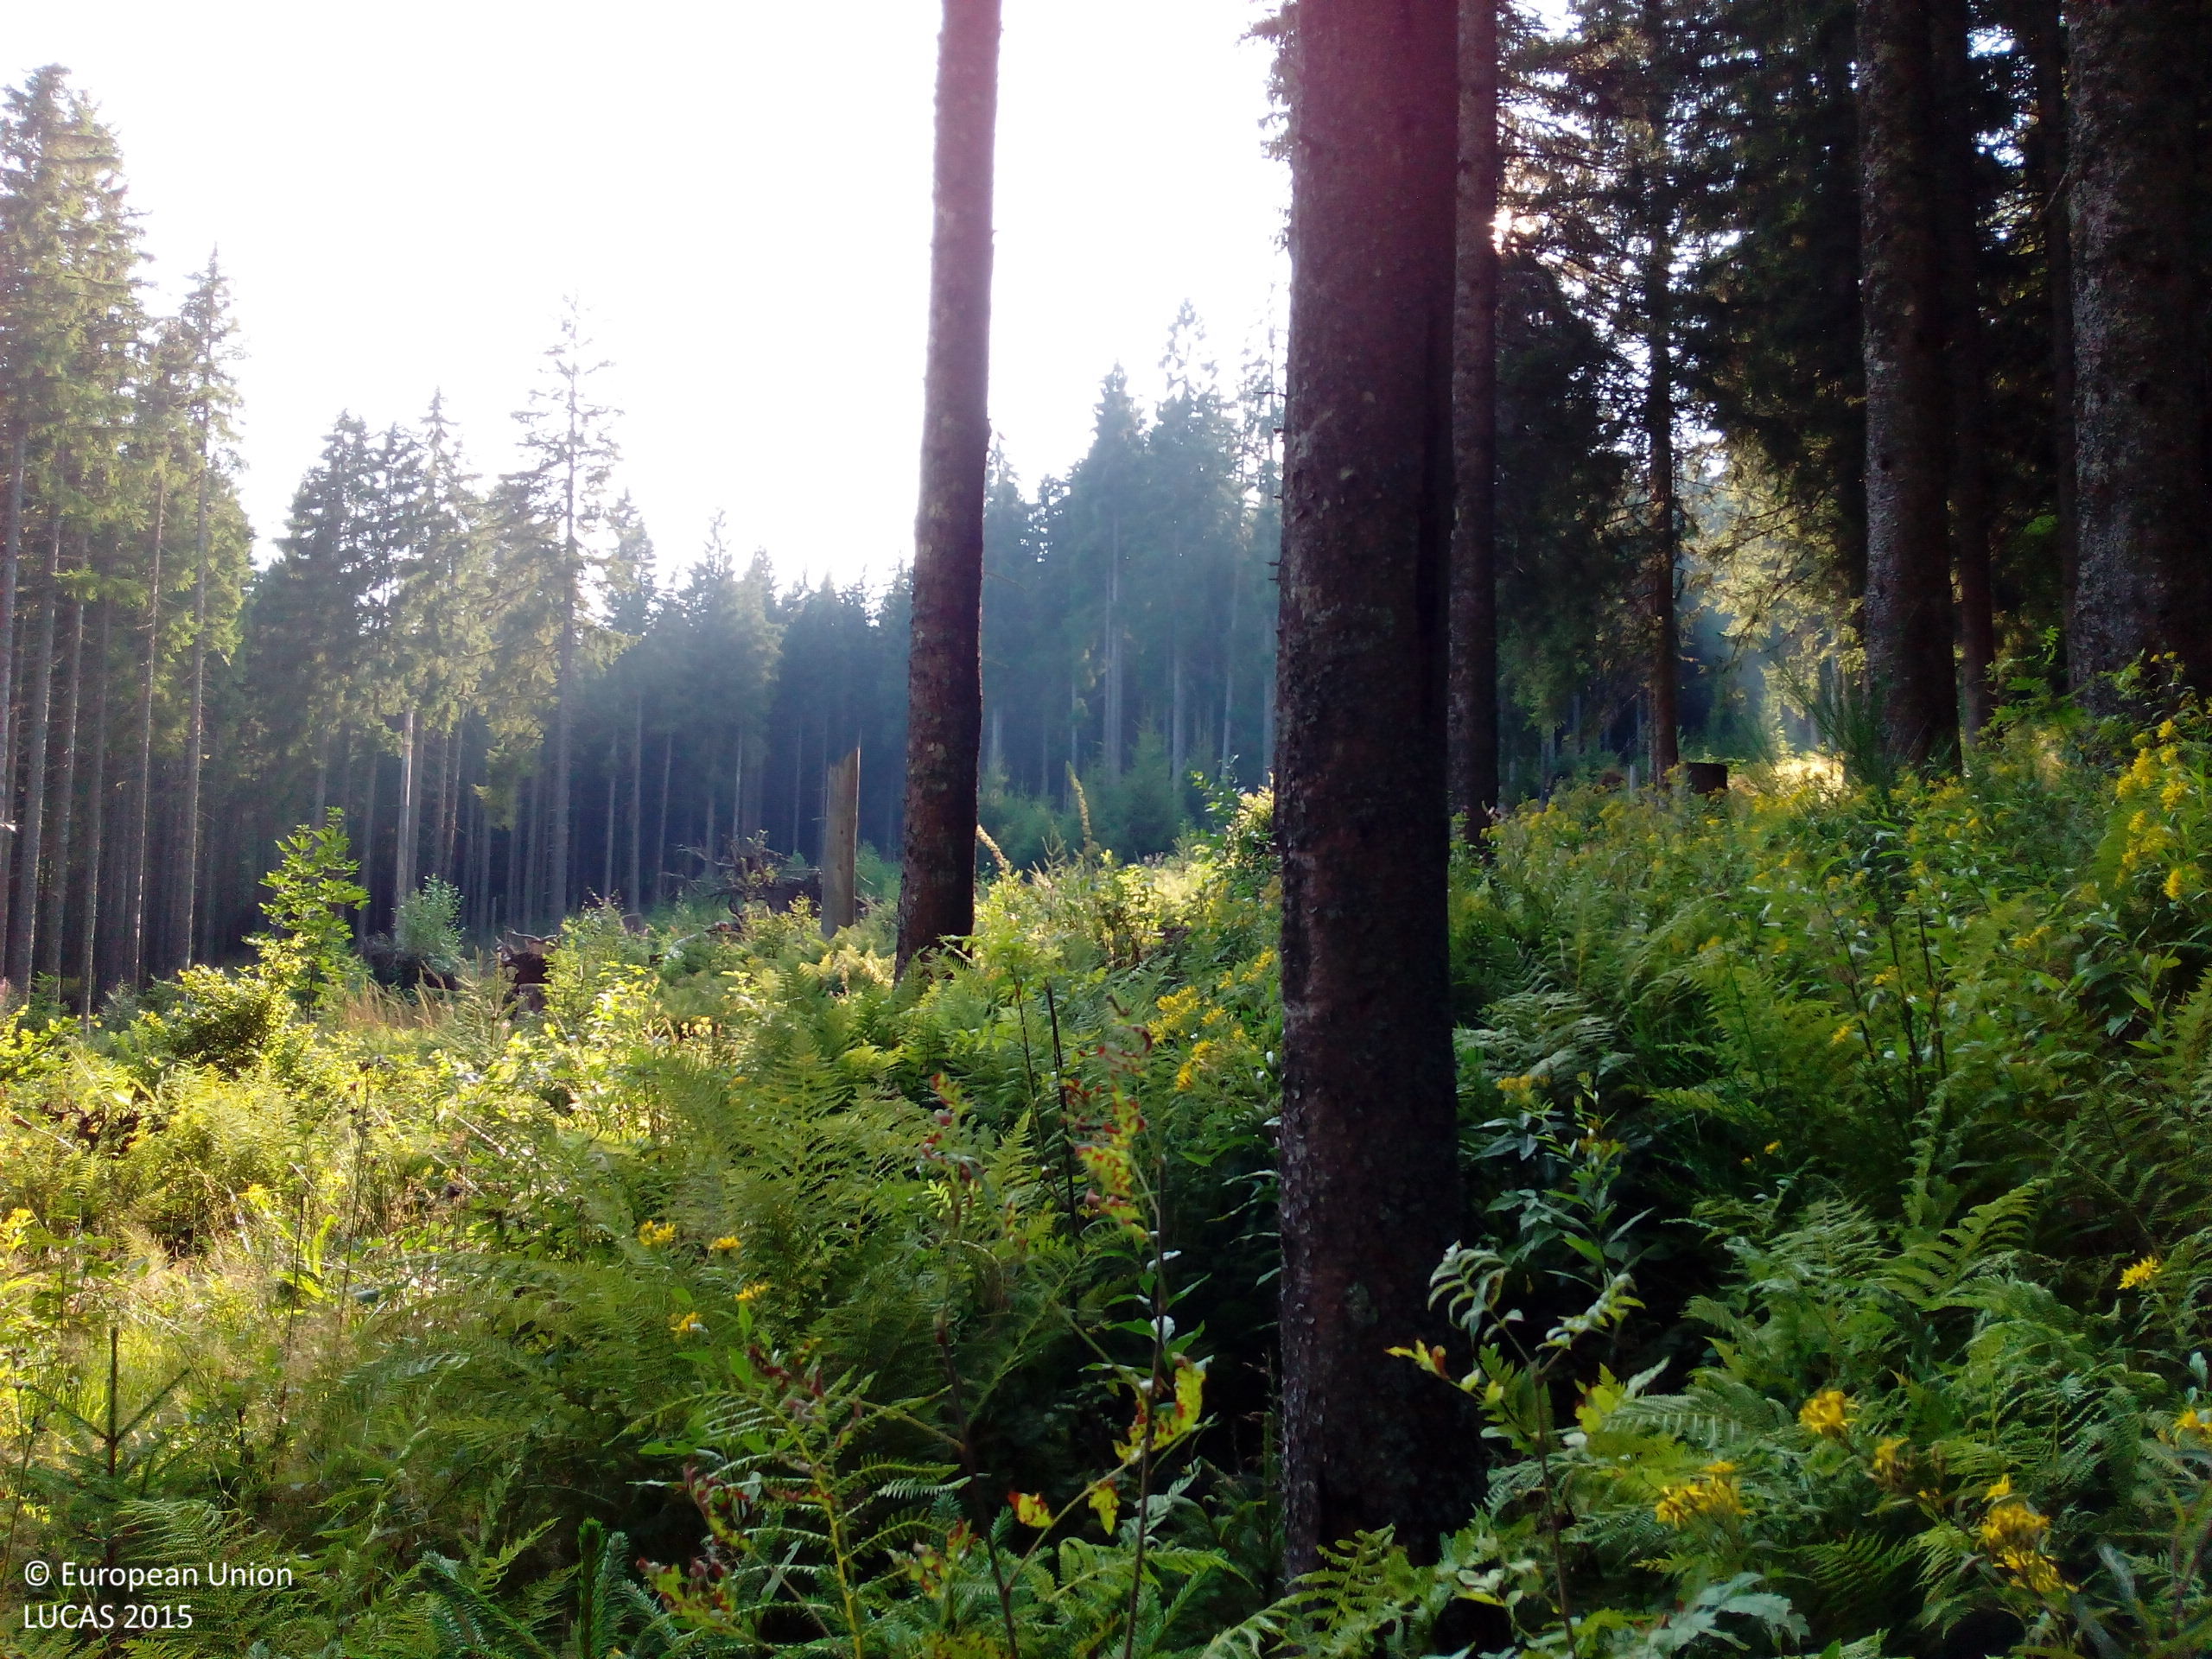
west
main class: Woodland
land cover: Spruce dominated coniferous woodland
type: hemiboreal forest and nemoral coniferous forest and mixed broadleaved-coniferous forest
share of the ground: 50 - 75 %
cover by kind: coniferous forest trees 60 %, shrubs 20 %, herbaceous plants 20 %
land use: Forestry
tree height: > 5 m
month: August
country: DE
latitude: 47.8475
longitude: 8.1170
